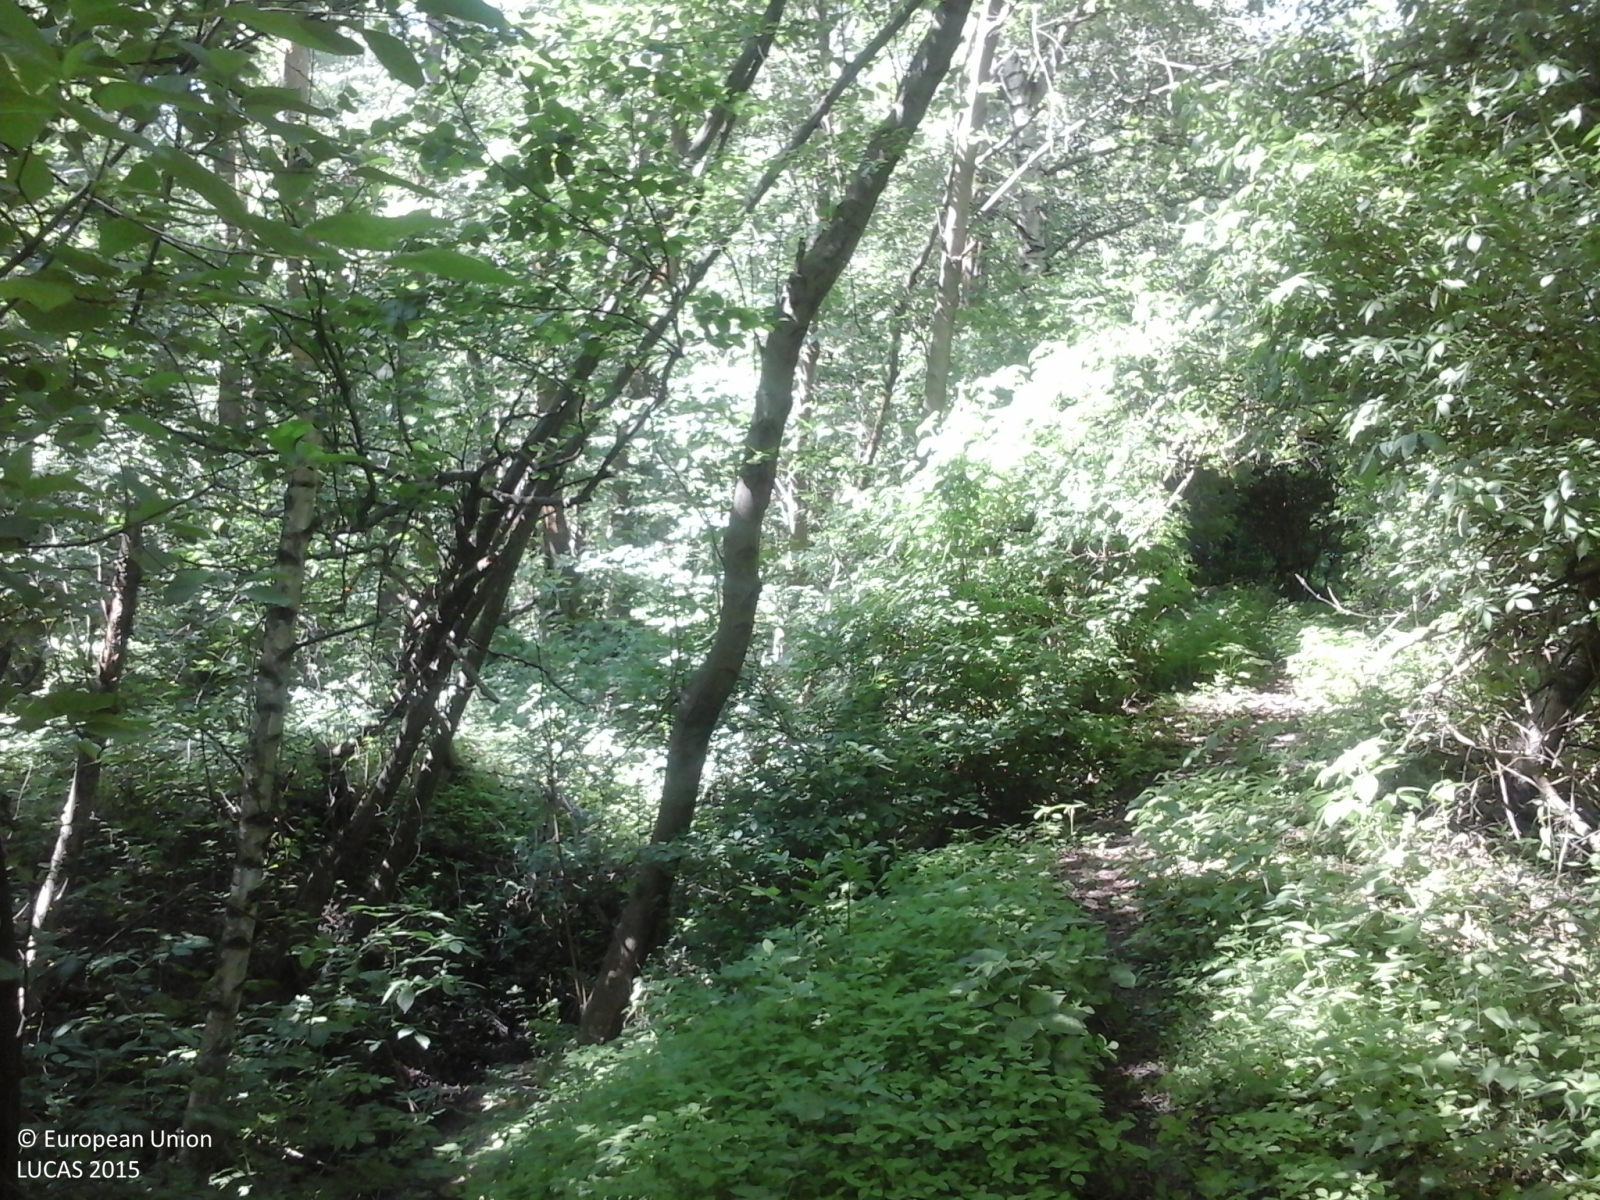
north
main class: Woodland
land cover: Broadleaved woodland
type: mesophytic deciduous forest
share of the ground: > 75 %
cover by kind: broadleaved forest trees 100 %
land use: Forestry
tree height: > 5 m
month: May
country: IT
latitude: 46.6195
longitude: 10.6391
